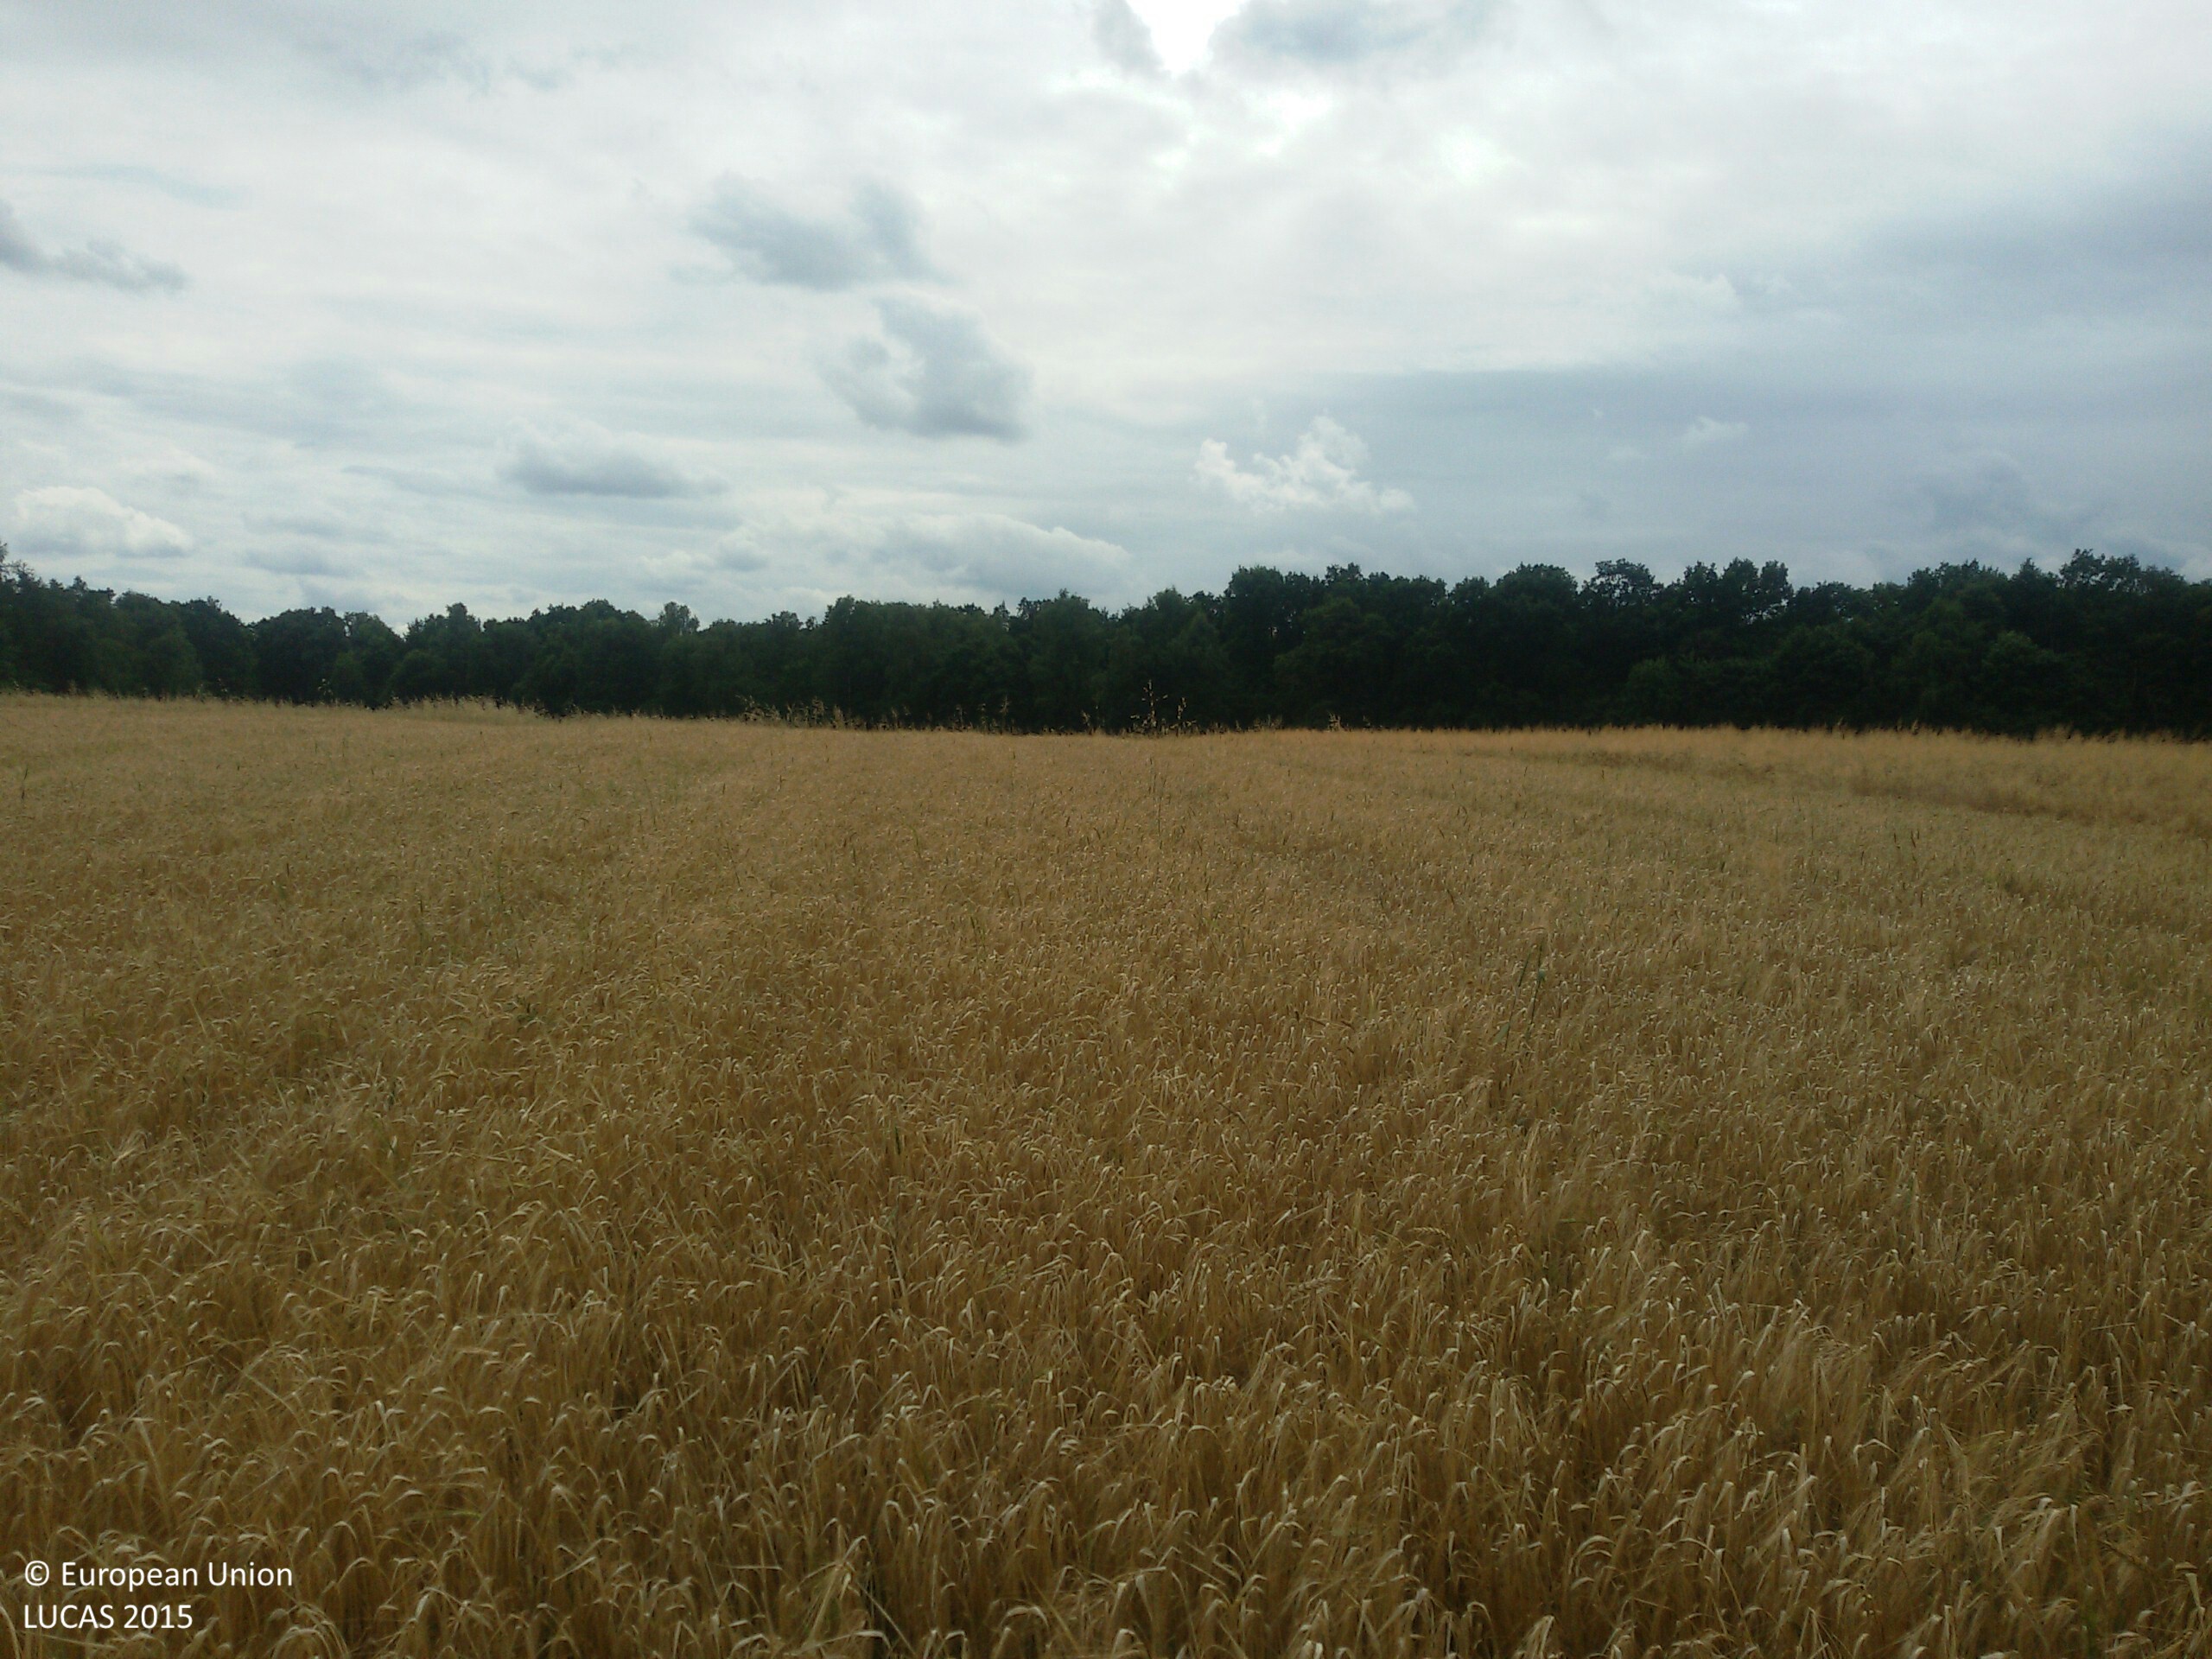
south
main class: Cropland
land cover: Barley
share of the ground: > 75 %
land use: Agriculture (excluding fallow land and kitchen gardens)
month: July
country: PL
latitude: 50.4670
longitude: 20.4203
